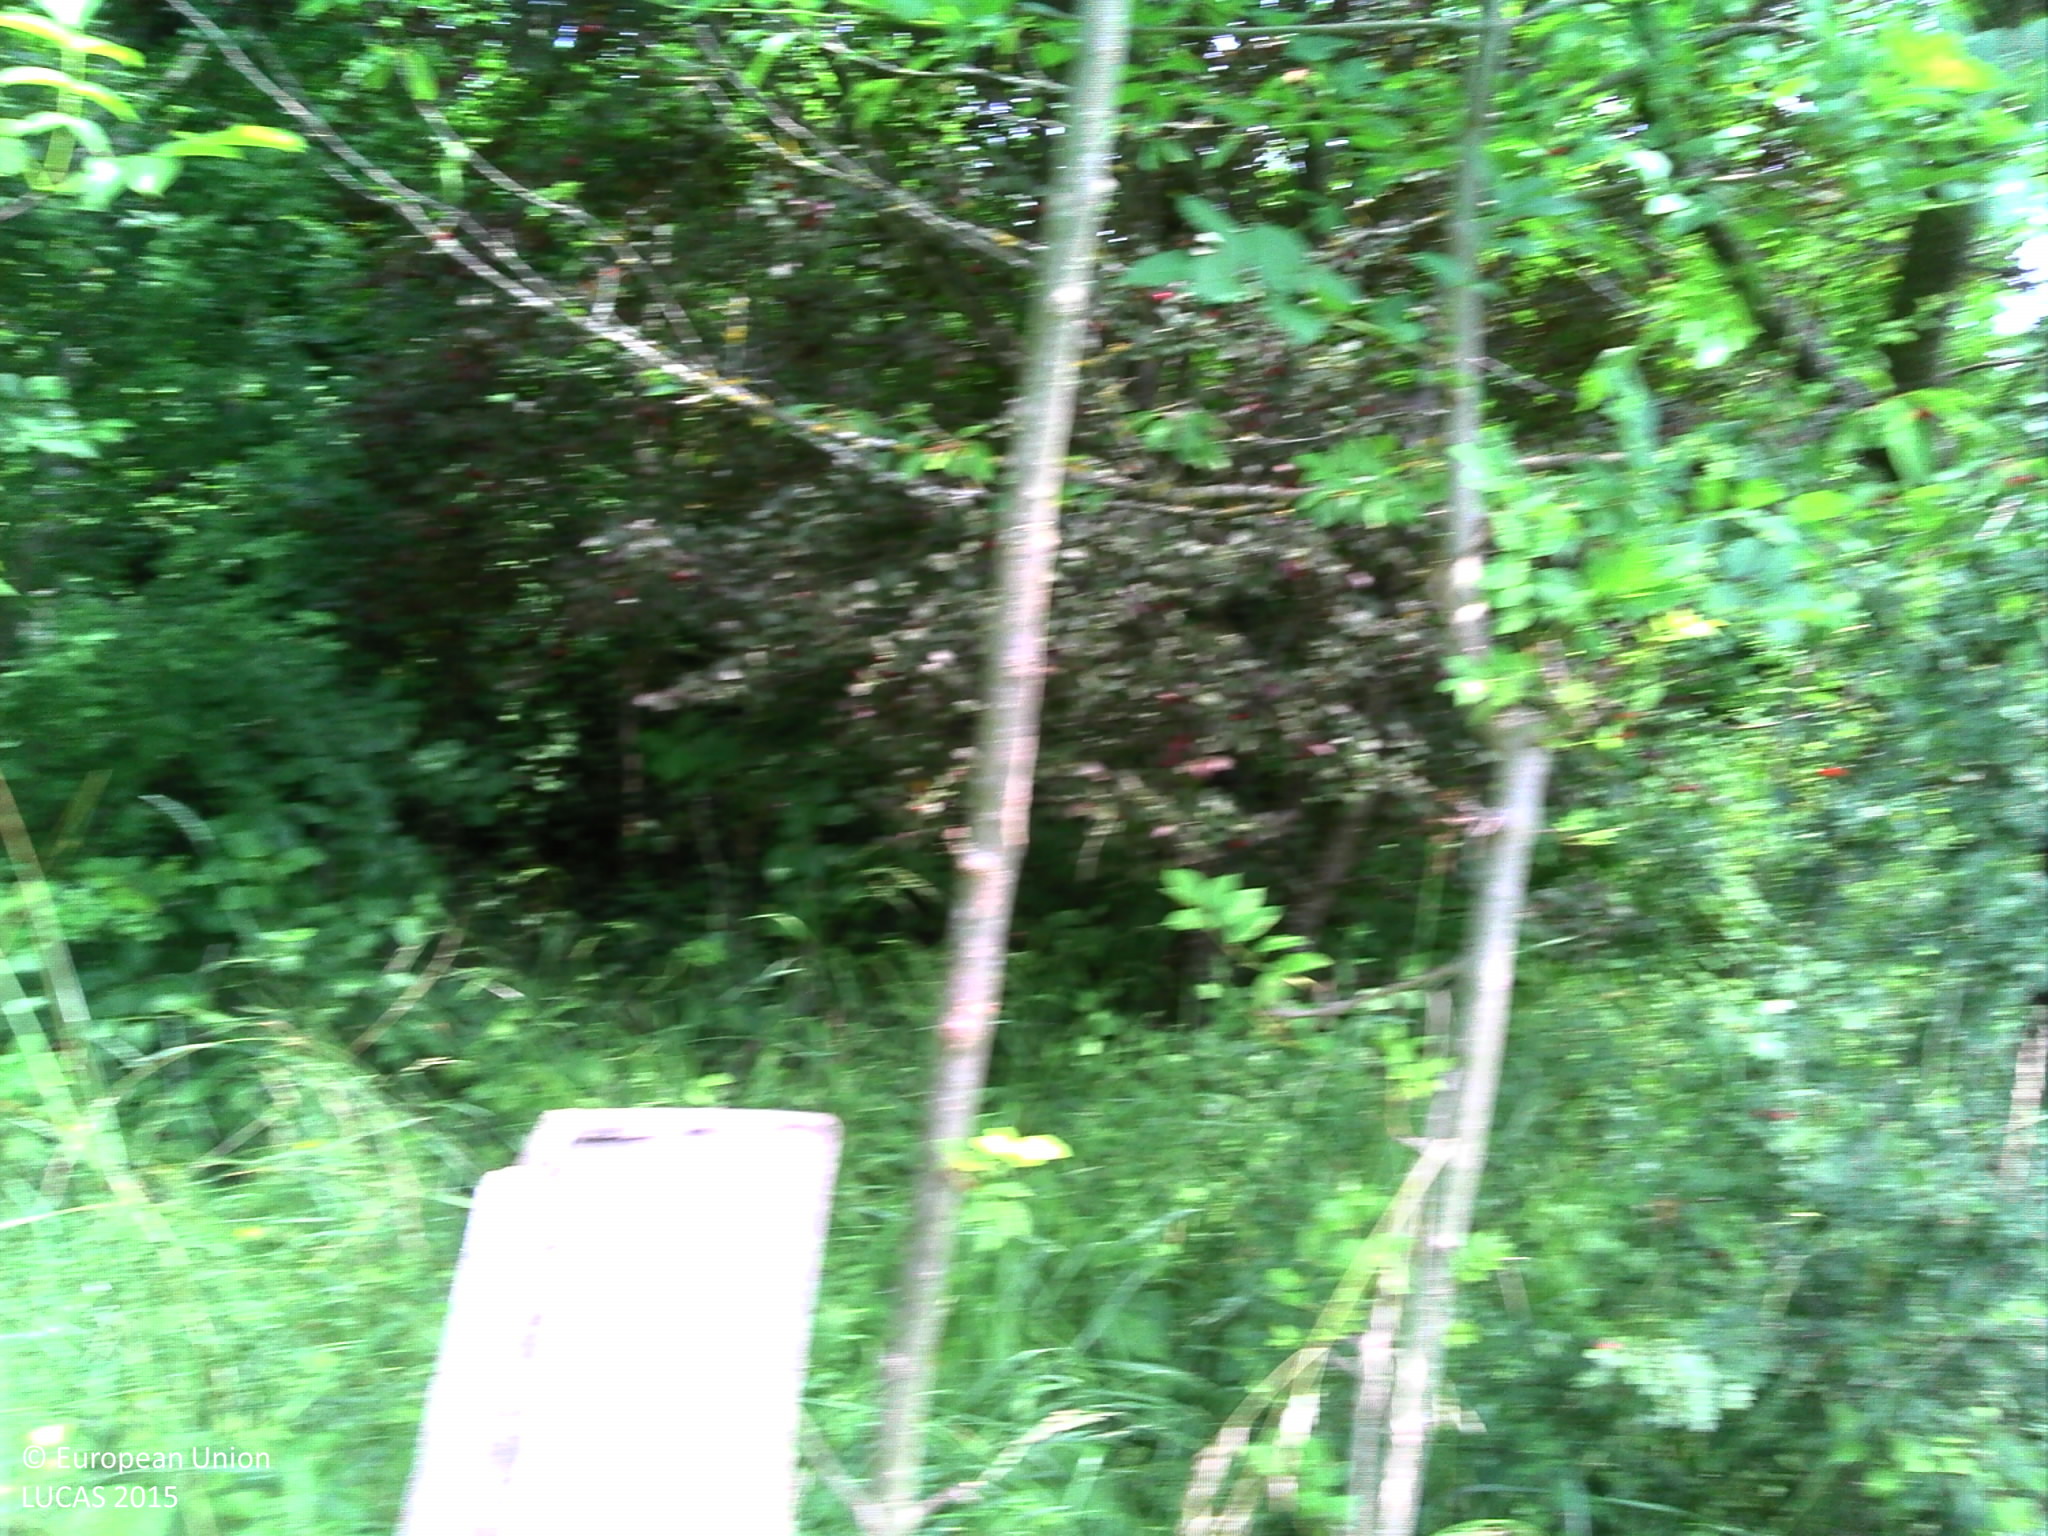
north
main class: Grassland
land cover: Grassland without tree/shrub cover
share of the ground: > 75 %
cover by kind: herbaceous plants 100 %
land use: Agriculture (excluding fallow land and kitchen gardens)
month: June
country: FR
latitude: 45.2606
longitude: 5.0221
